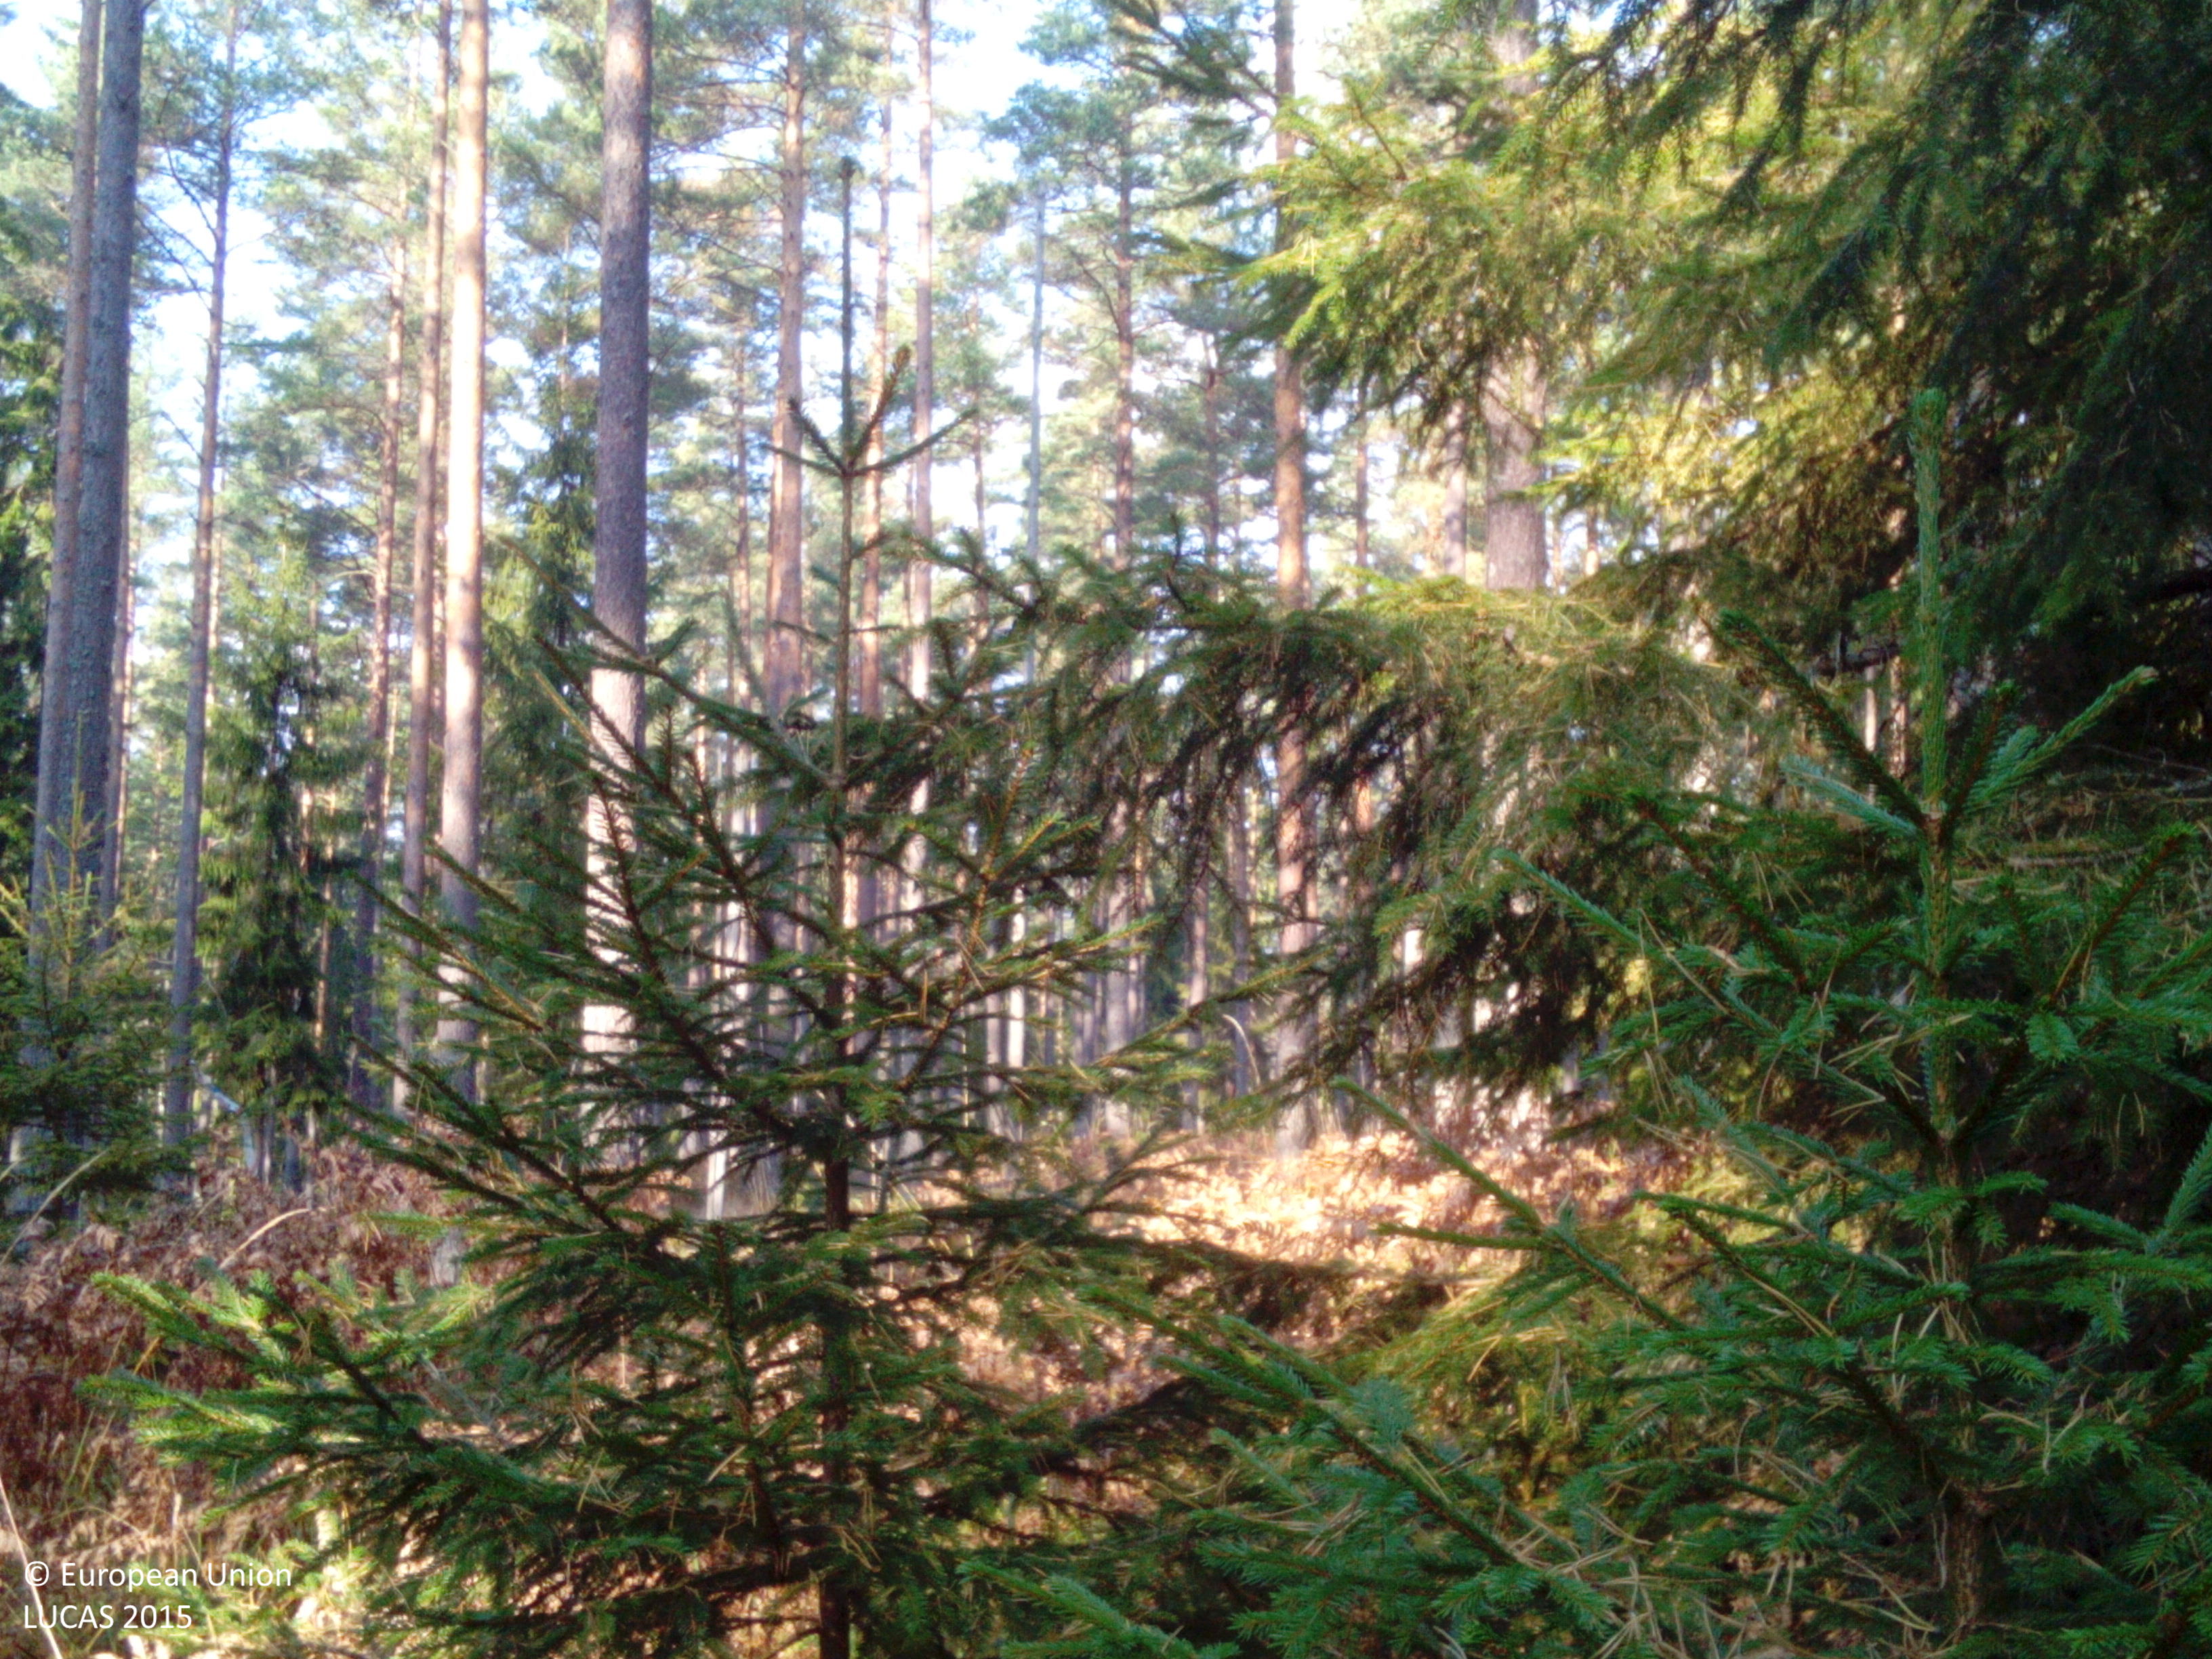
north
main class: Woodland
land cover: Other coniferous woodland
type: boreal forest
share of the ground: > 75 %
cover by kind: coniferous forest trees 85 %, herbaceous plants 10 %, lichens and mosses 5 %
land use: Forestry
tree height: > 5 m
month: October
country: SE
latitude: 58.8877
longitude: 16.2231
